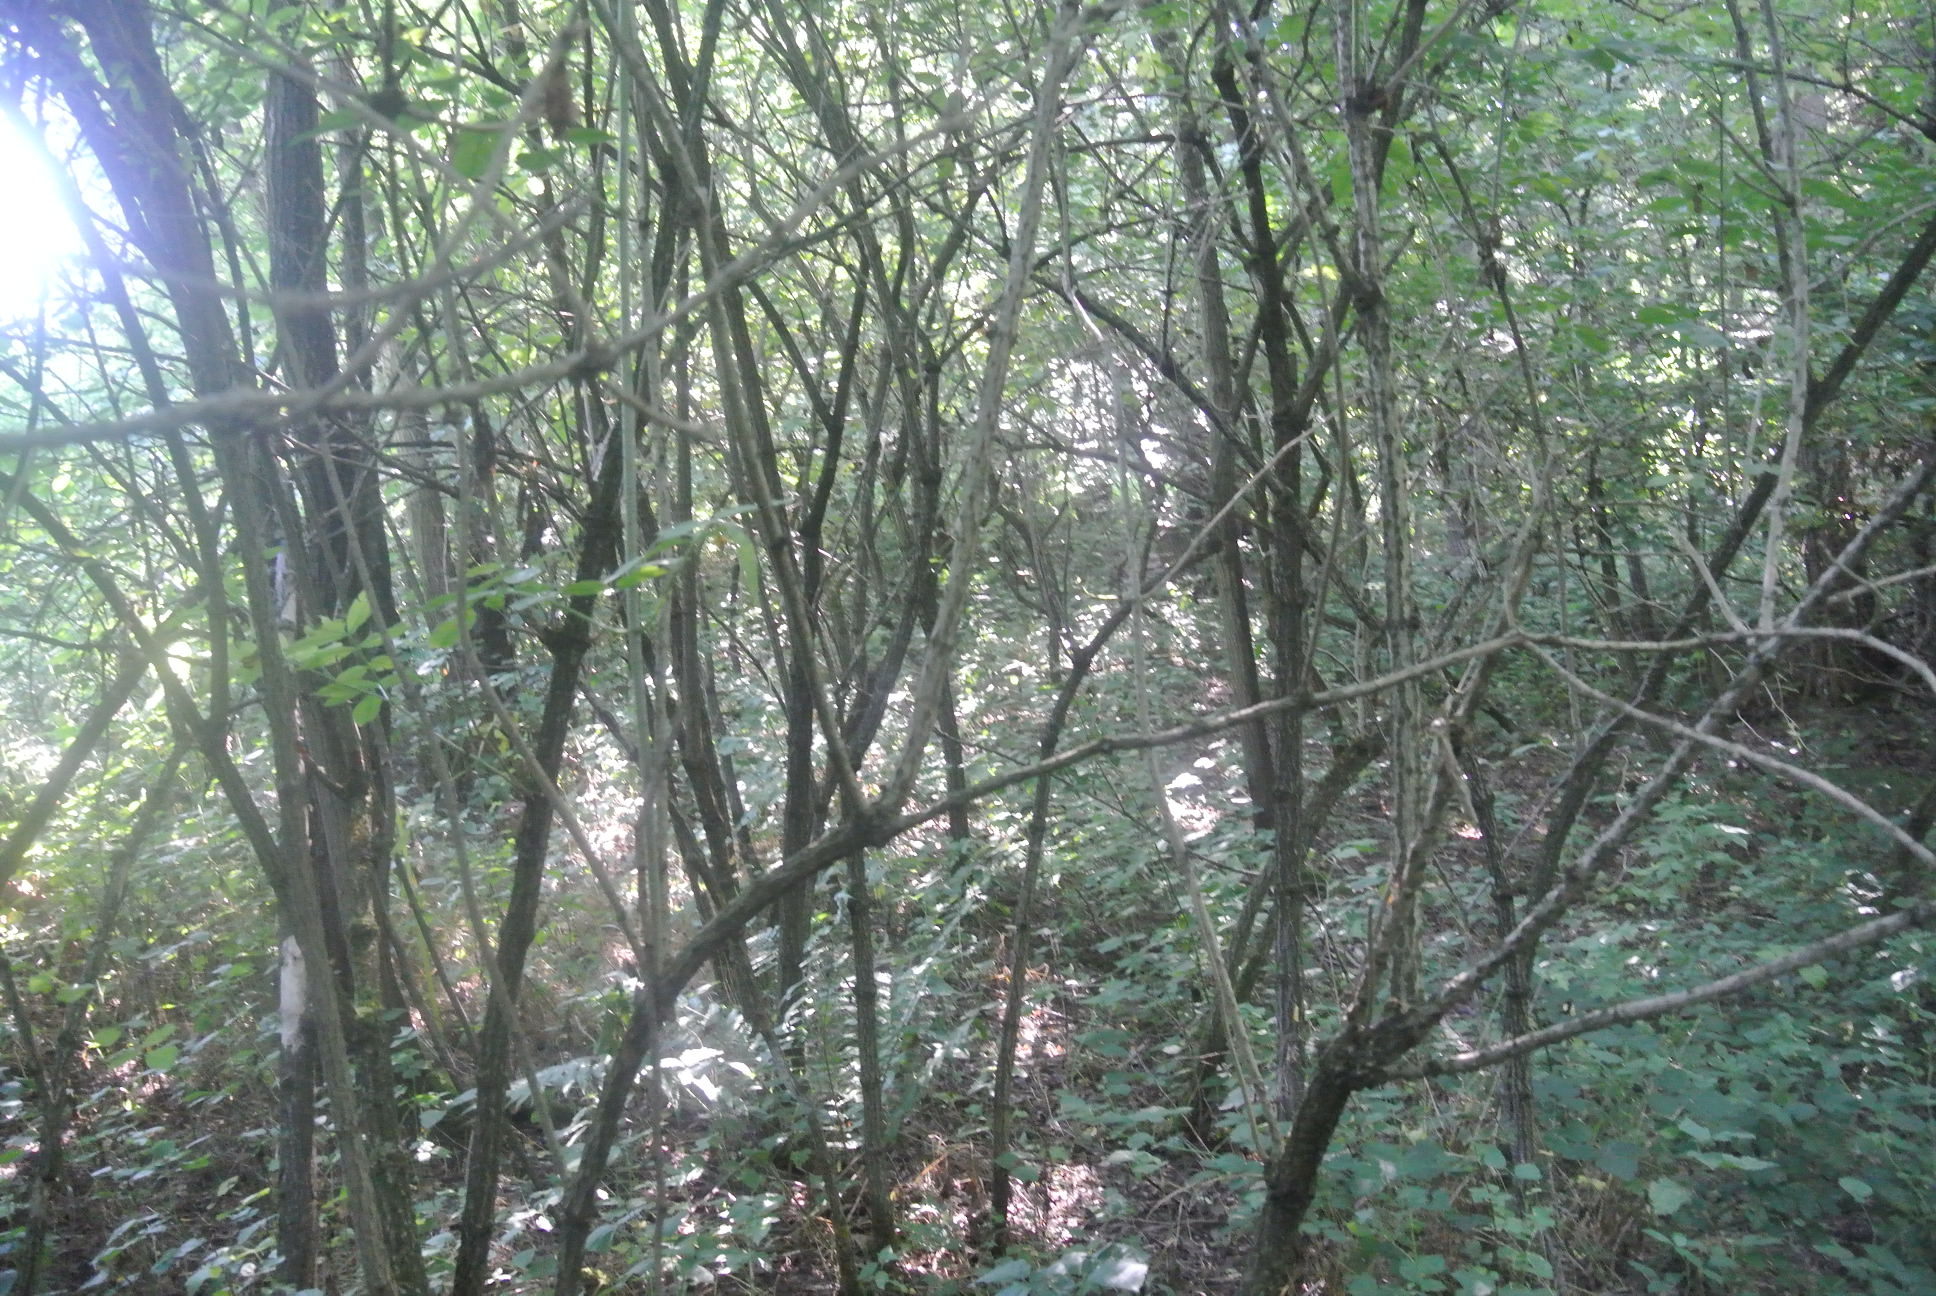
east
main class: Woodland
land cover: Broadleaved woodland
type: exotic forest
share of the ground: > 75 %
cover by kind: broadleaved forest trees 100 %
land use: Forestry
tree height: > 5 m
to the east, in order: Broadleaved woodland; Other mixed woodland; Tracks; Spruce dominated mixed woodland; Other mixed woodland
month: July
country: AT
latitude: 47.5652
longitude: 16.4502
